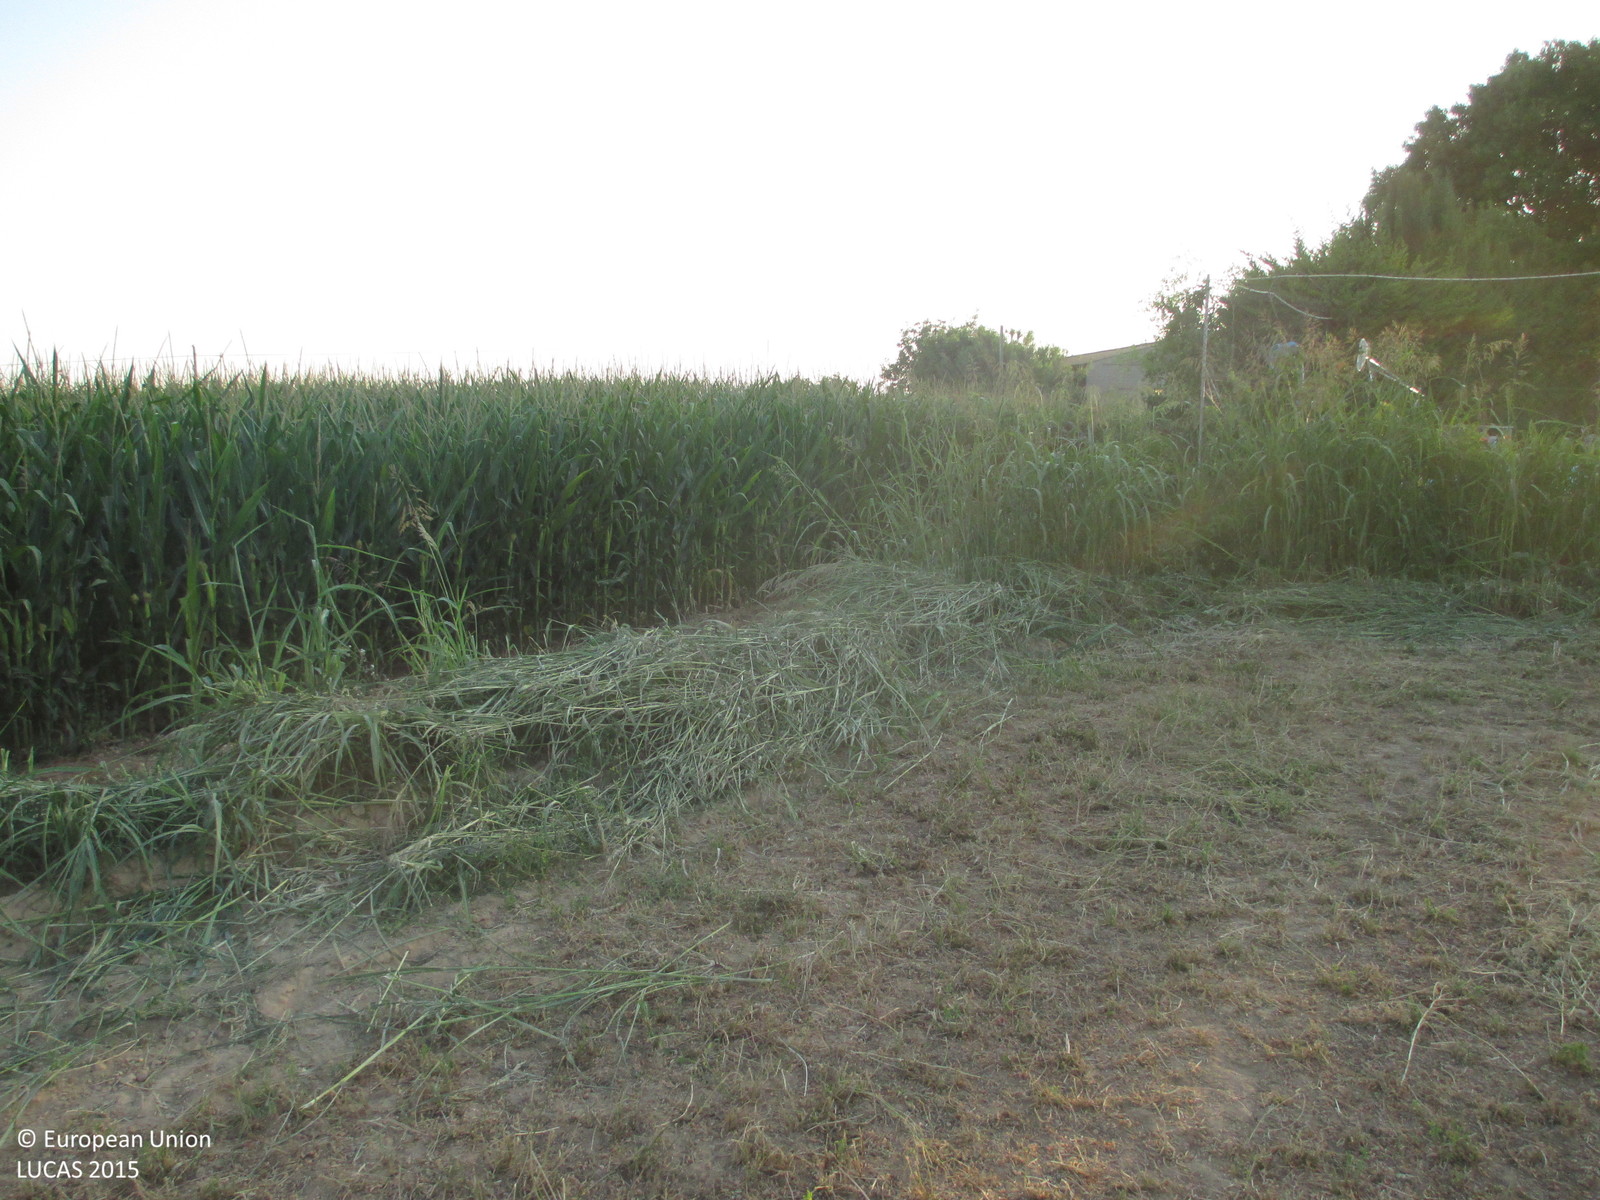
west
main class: Cropland
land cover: Lucerne
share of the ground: > 75 %
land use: Agriculture (excluding fallow land and kitchen gardens)
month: July
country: ES
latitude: 41.8502
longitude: 0.3851
